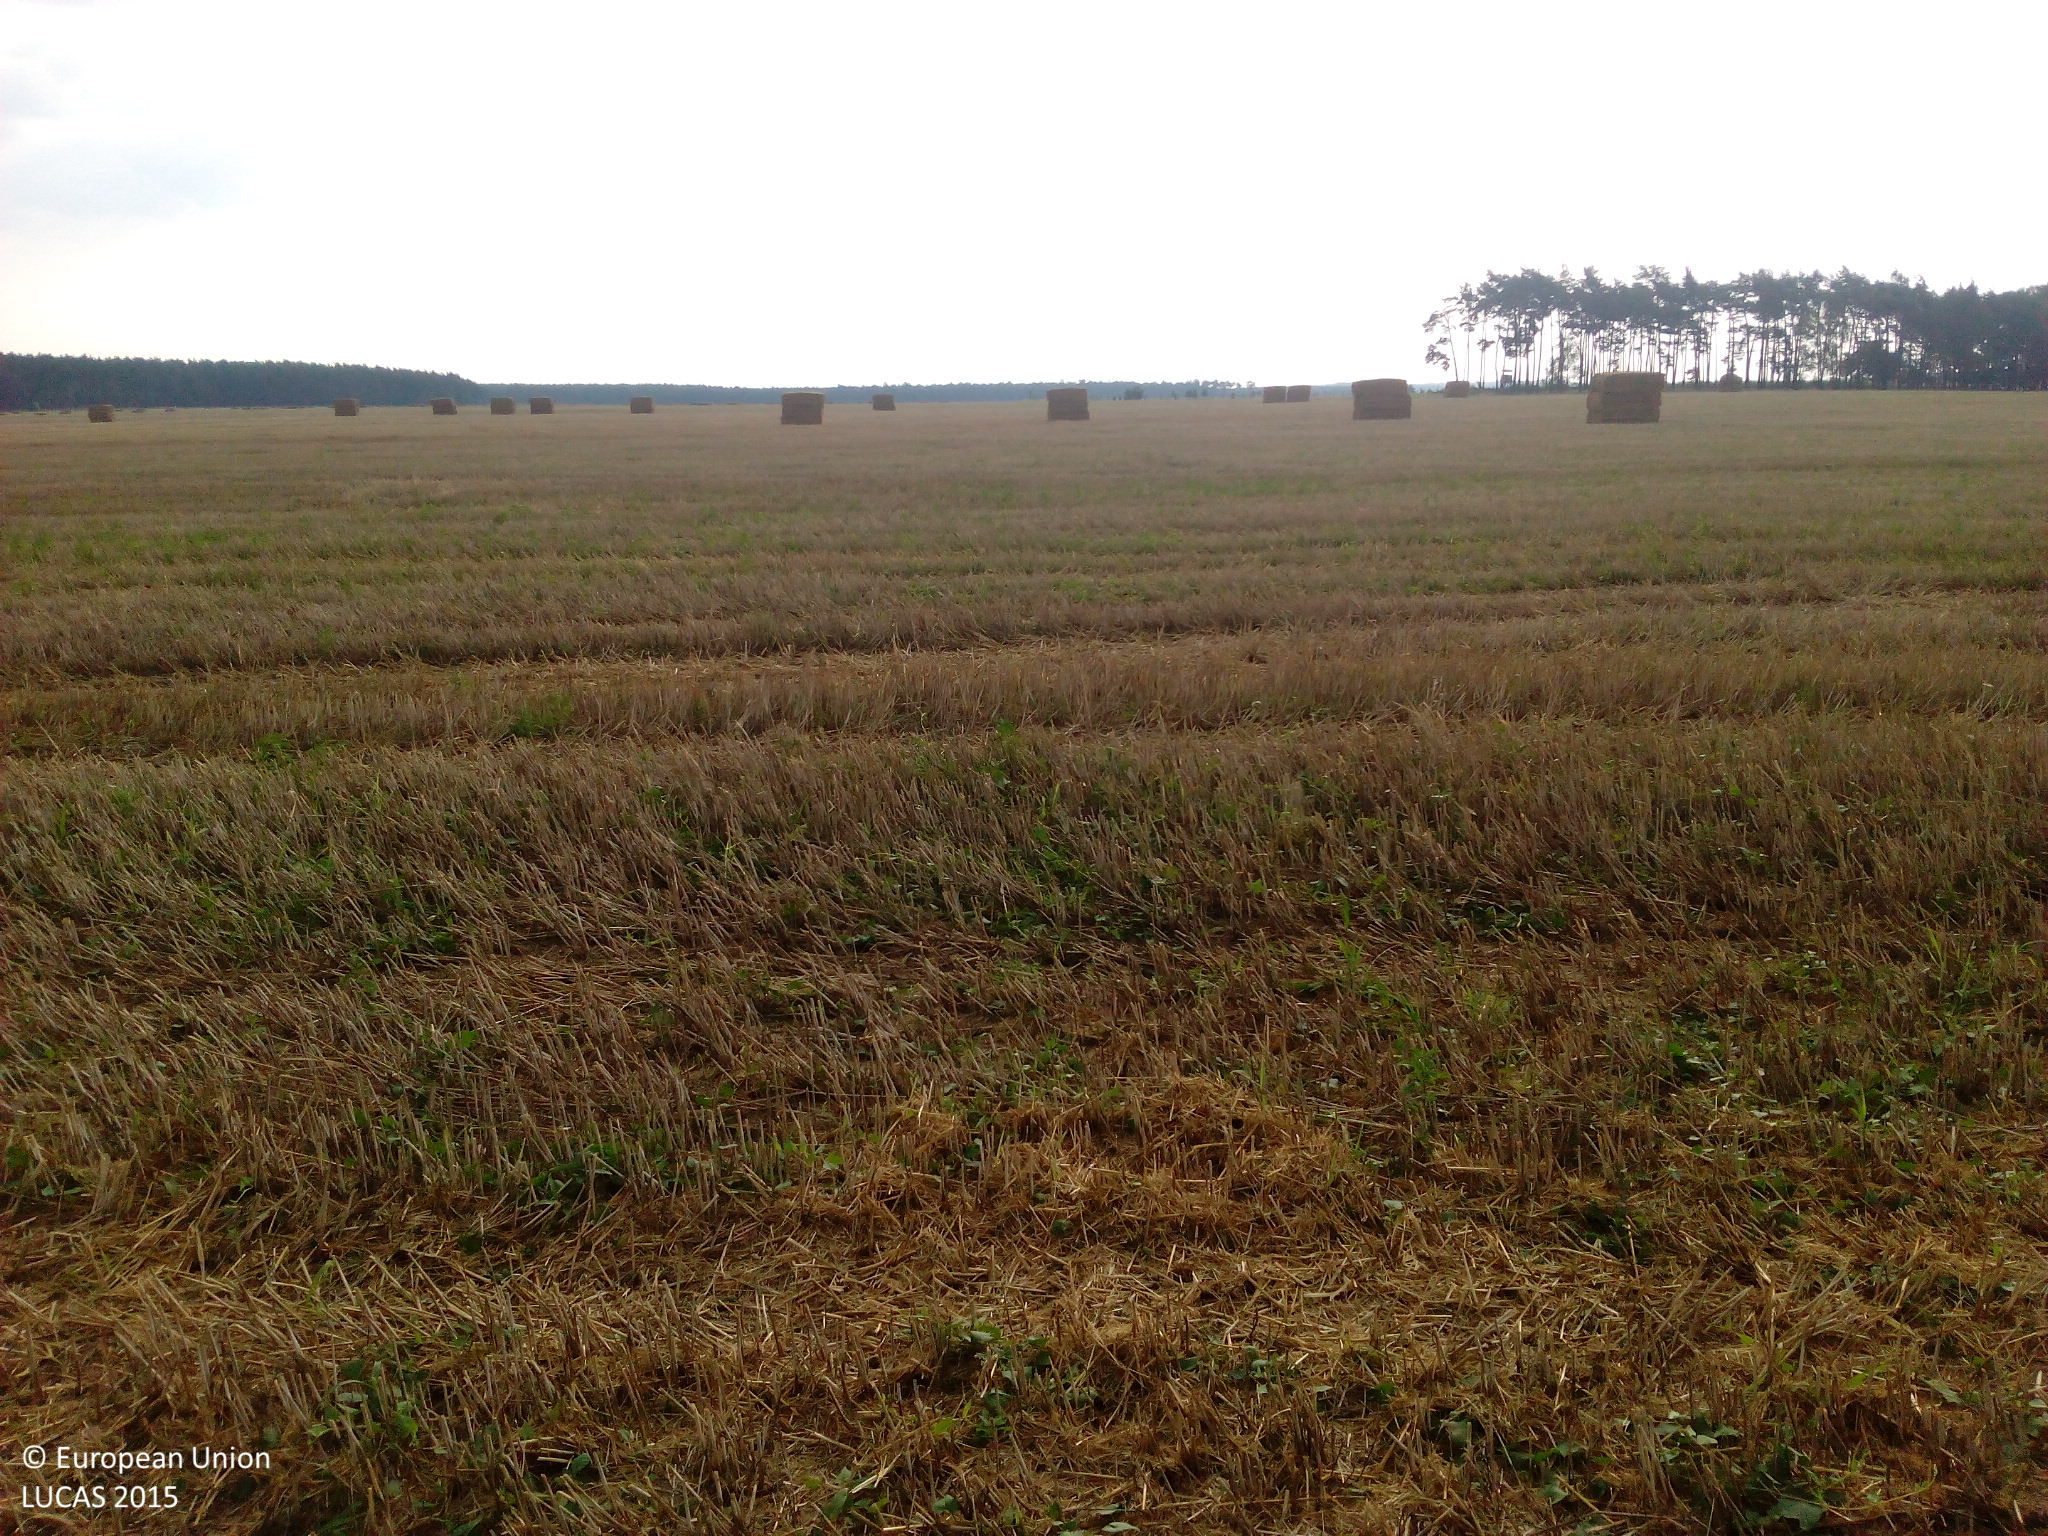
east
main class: Cropland
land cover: Rye
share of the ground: 25 - 50 %
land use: Agriculture (excluding fallow land and kitchen gardens)
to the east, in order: Rye
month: August
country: DE
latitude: 51.8500
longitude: 13.1503
